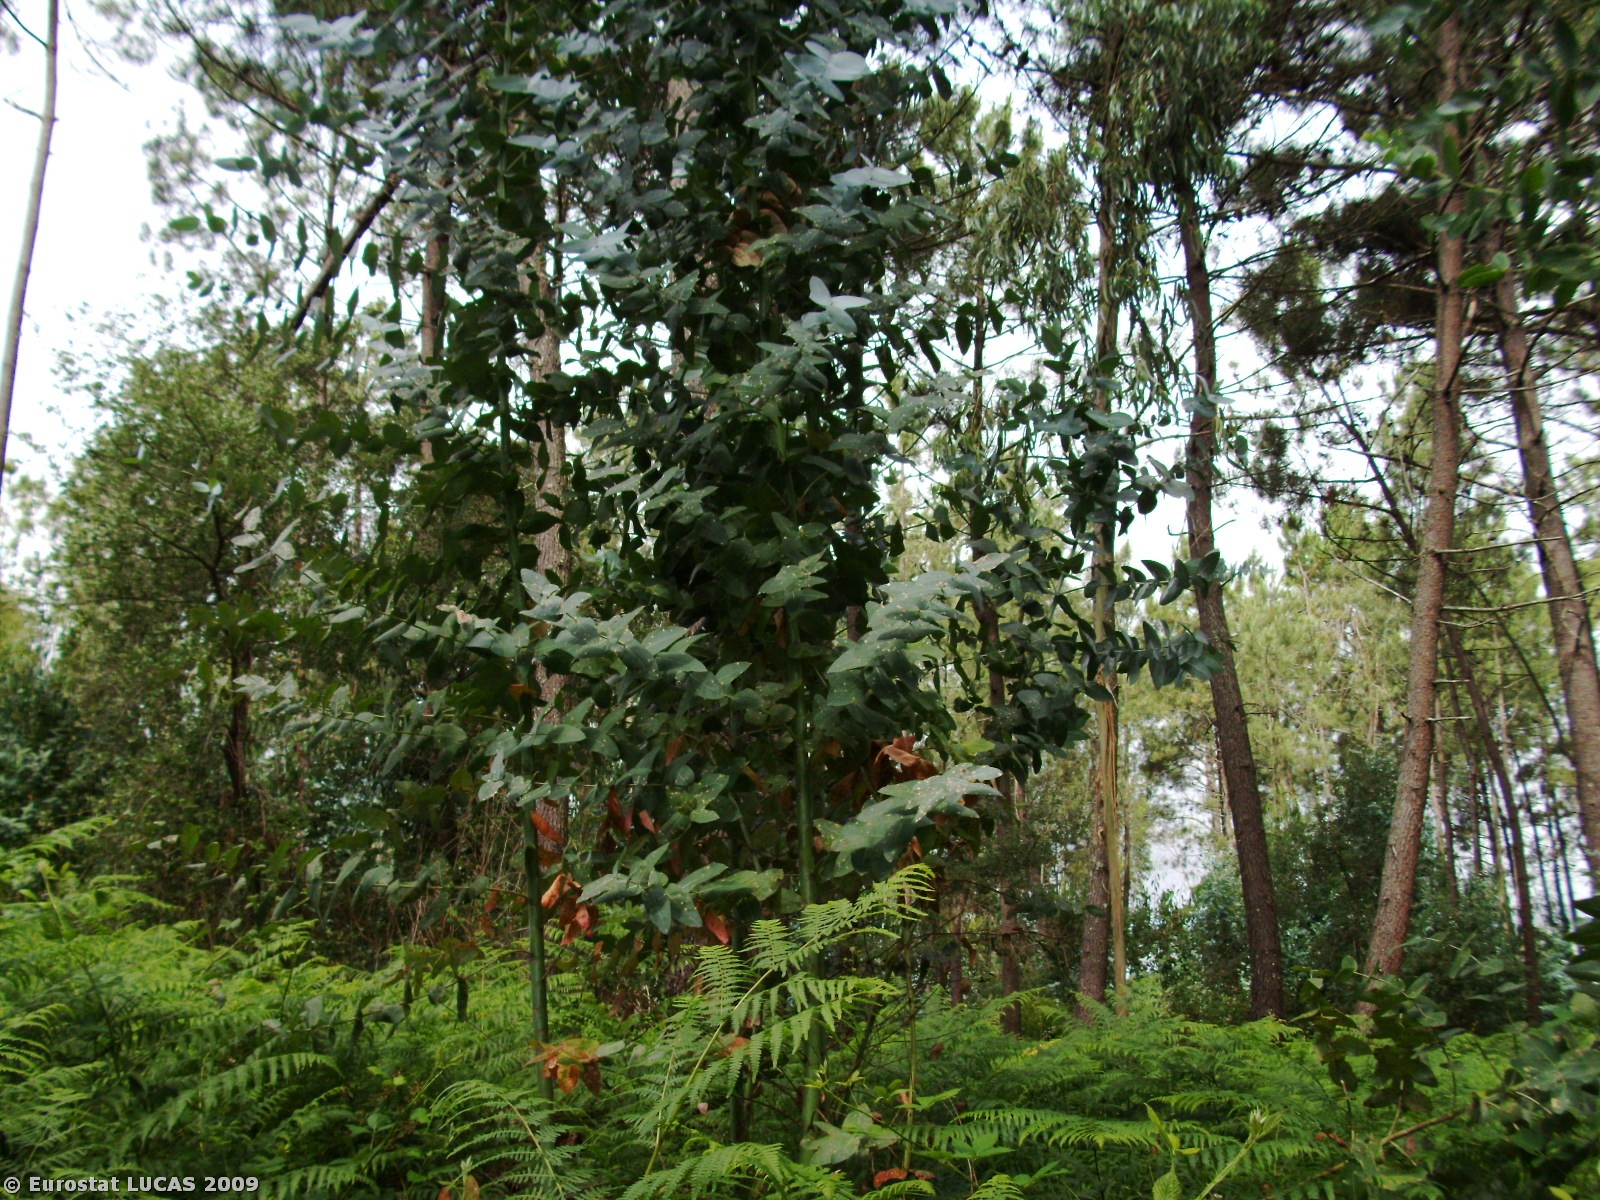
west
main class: Woodland
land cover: Mixed woodland
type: coniferous forest of the mediterranean region
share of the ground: > 75 %
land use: Forestry
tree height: > 5 m
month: June
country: PT
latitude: 39.7651
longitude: -8.3180
